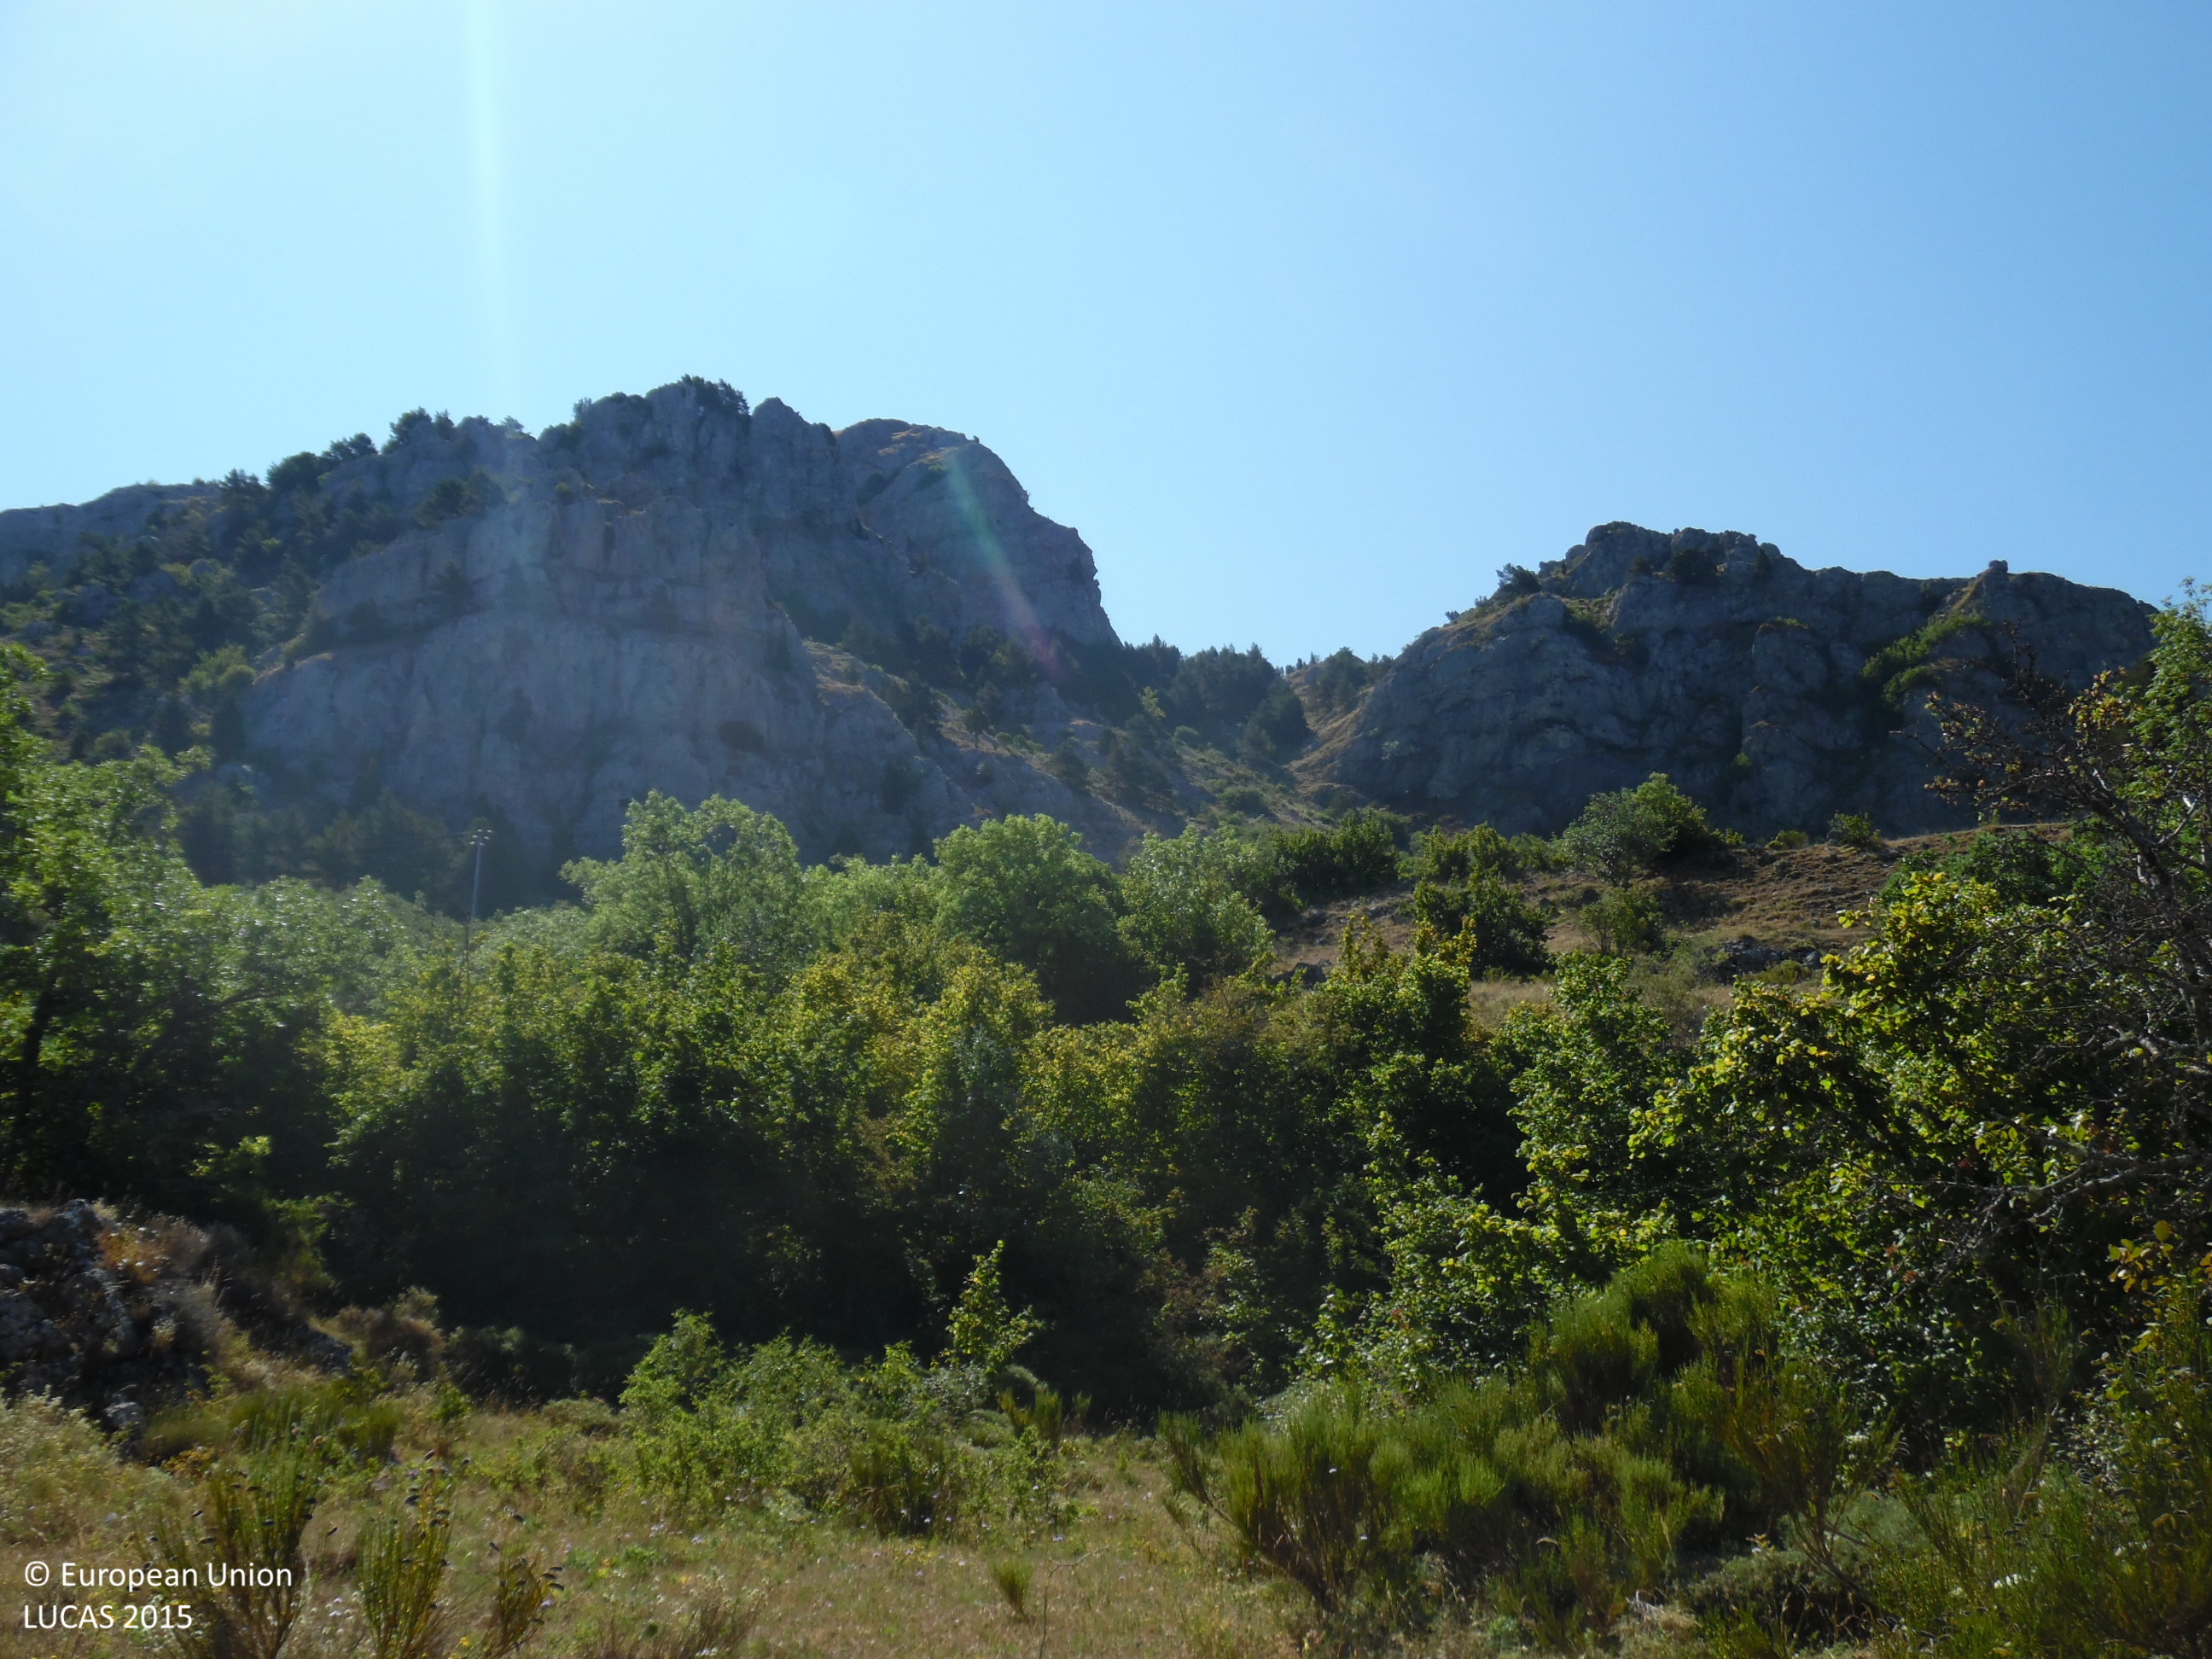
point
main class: Woodland
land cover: Broadleaved woodland
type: mountainous beech forest
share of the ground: > 75 %
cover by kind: broadleaved forest trees 90 %, shrubs 5 %, herbaceous plants 5 %
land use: Forestry
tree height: > 5 m
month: July
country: ES
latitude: 42.8645
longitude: -5.8593
